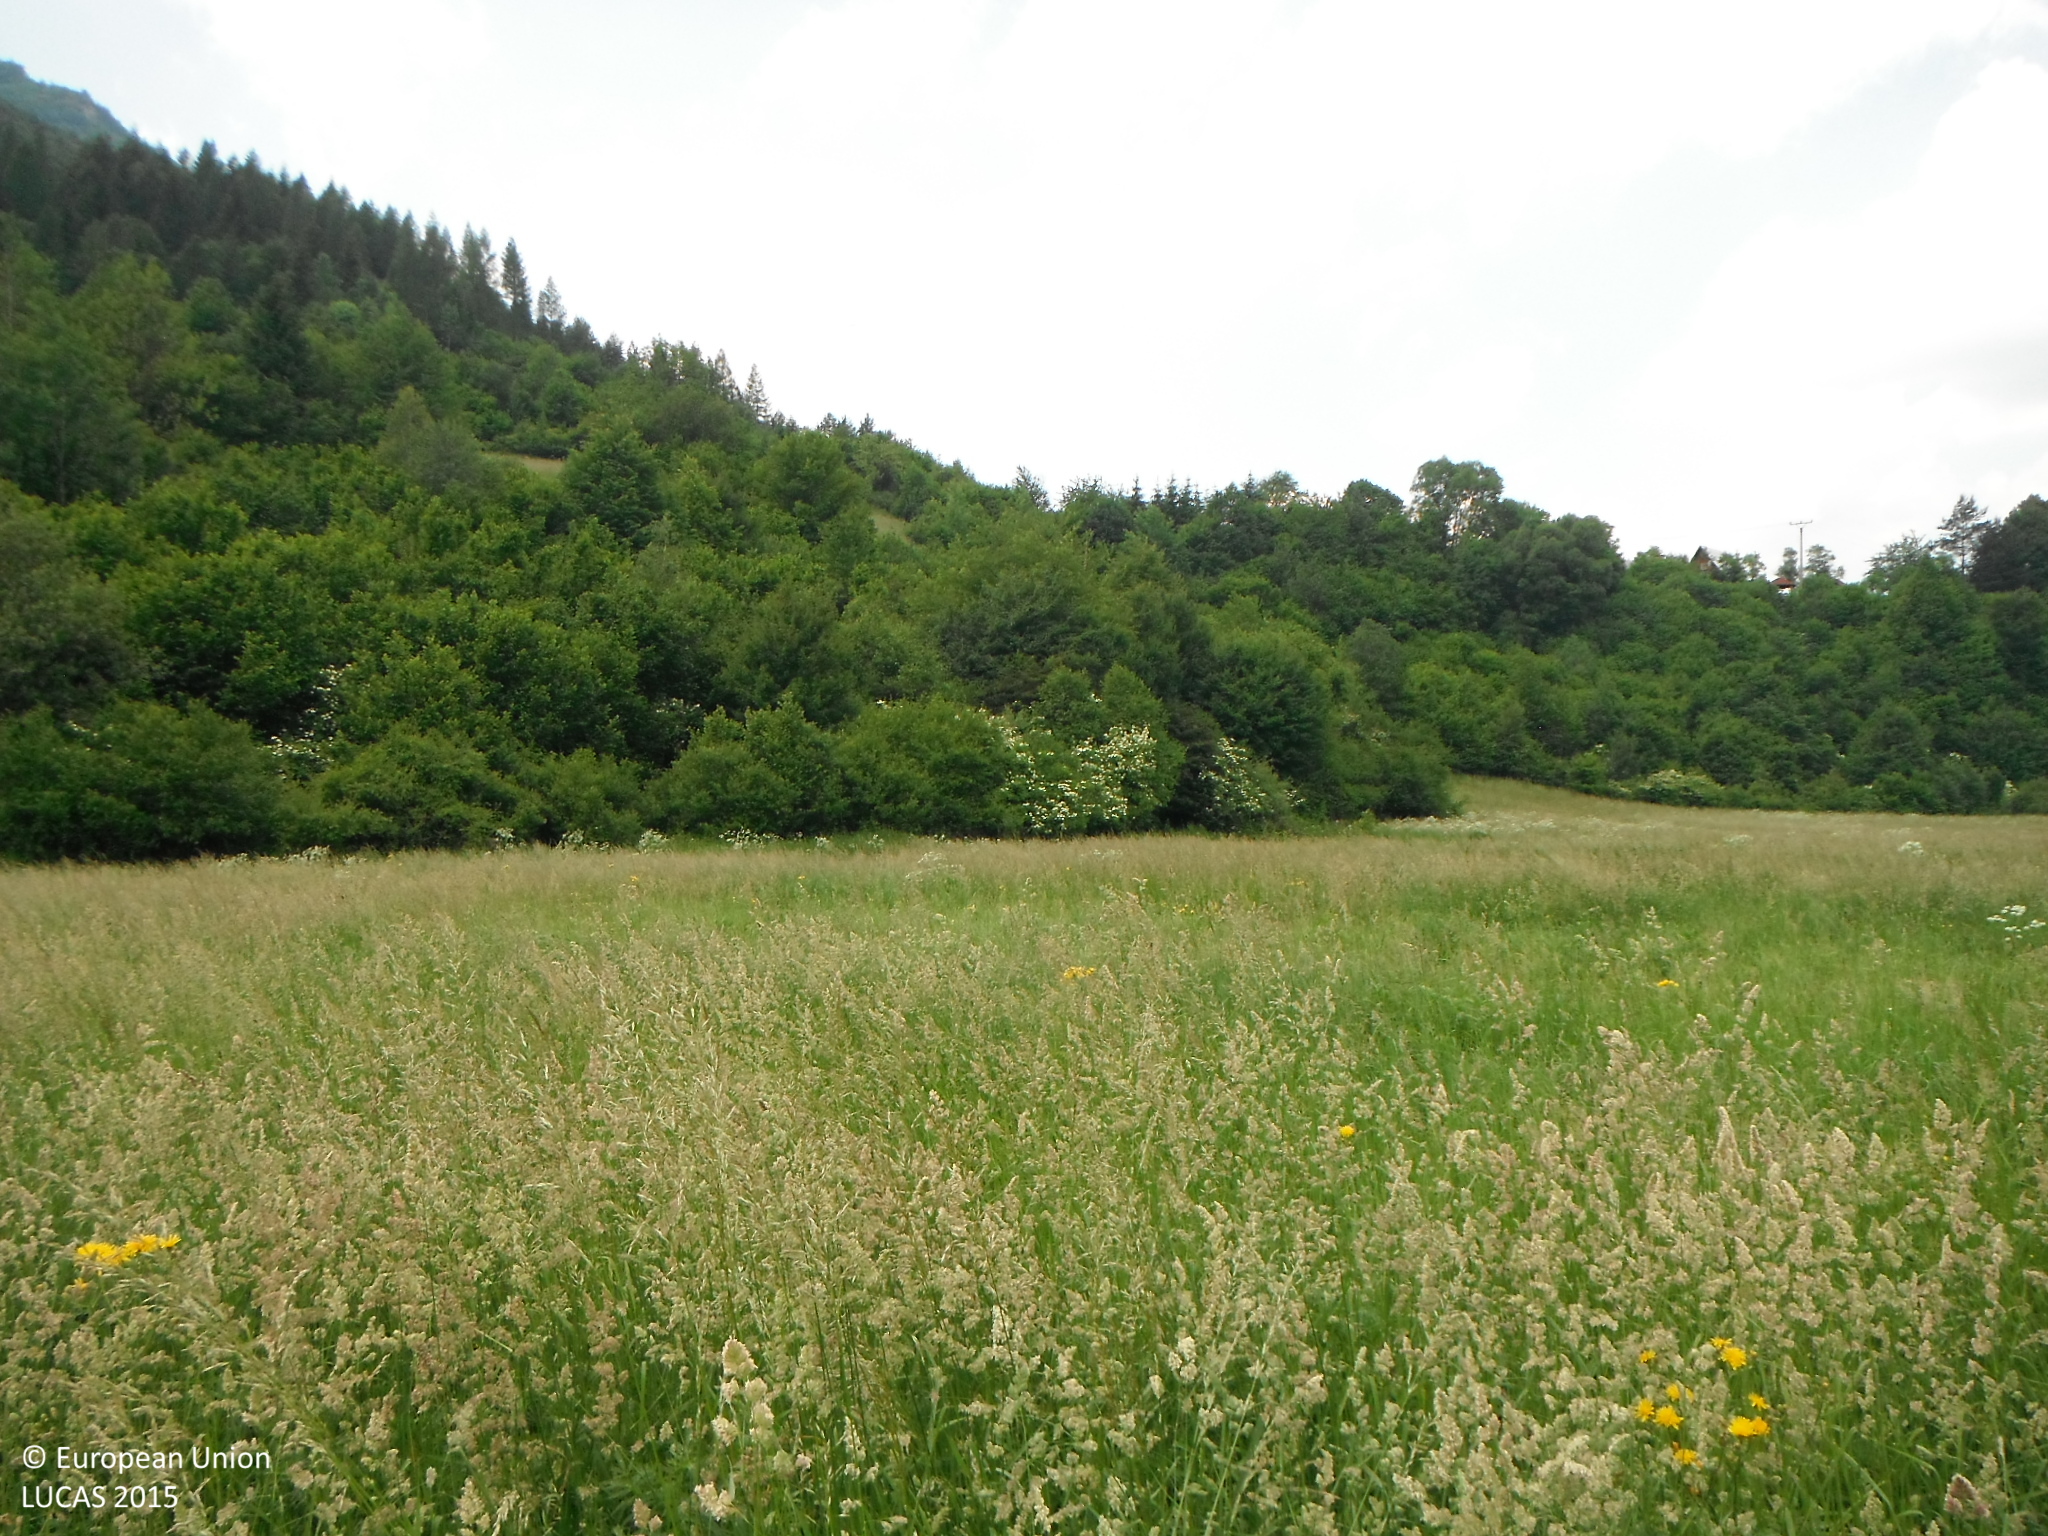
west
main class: Grassland
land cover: Grassland without tree/shrub cover
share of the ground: > 75 %
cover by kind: herbaceous plants 100 %
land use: Agriculture (excluding fallow land and kitchen gardens)
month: June
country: SK
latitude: 49.1445
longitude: 19.1669
